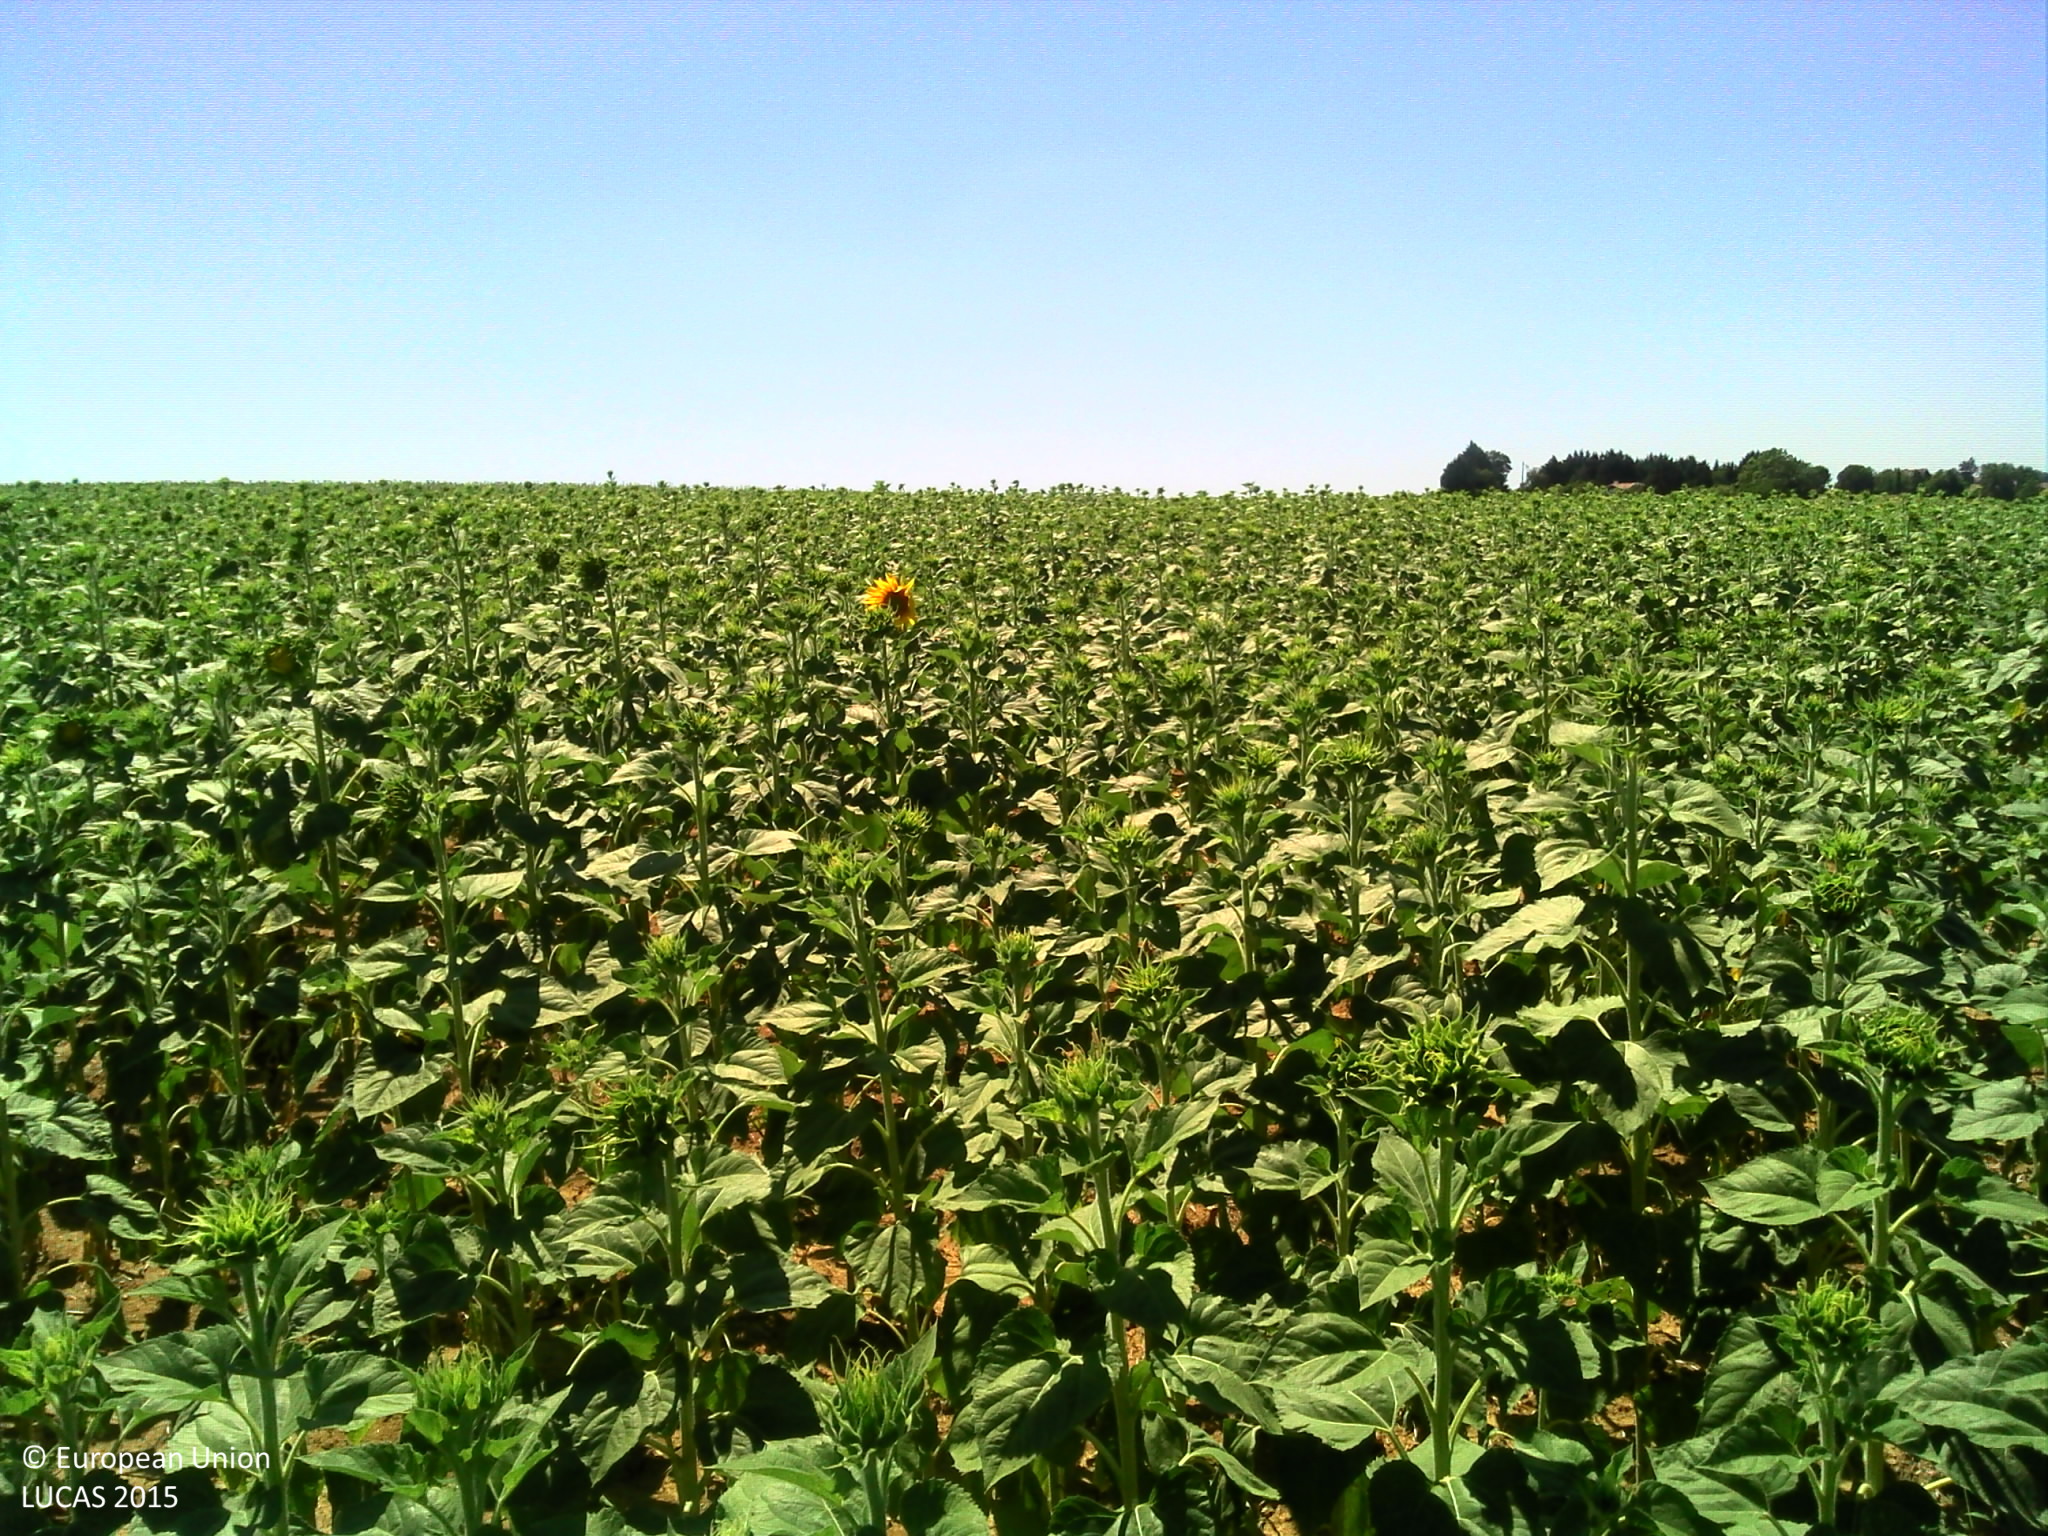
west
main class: Cropland
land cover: Sunflower
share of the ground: > 75 %
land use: Agriculture (excluding fallow land and kitchen gardens)
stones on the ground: < 10 %
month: July
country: FR
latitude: 44.0051
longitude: 0.7047
